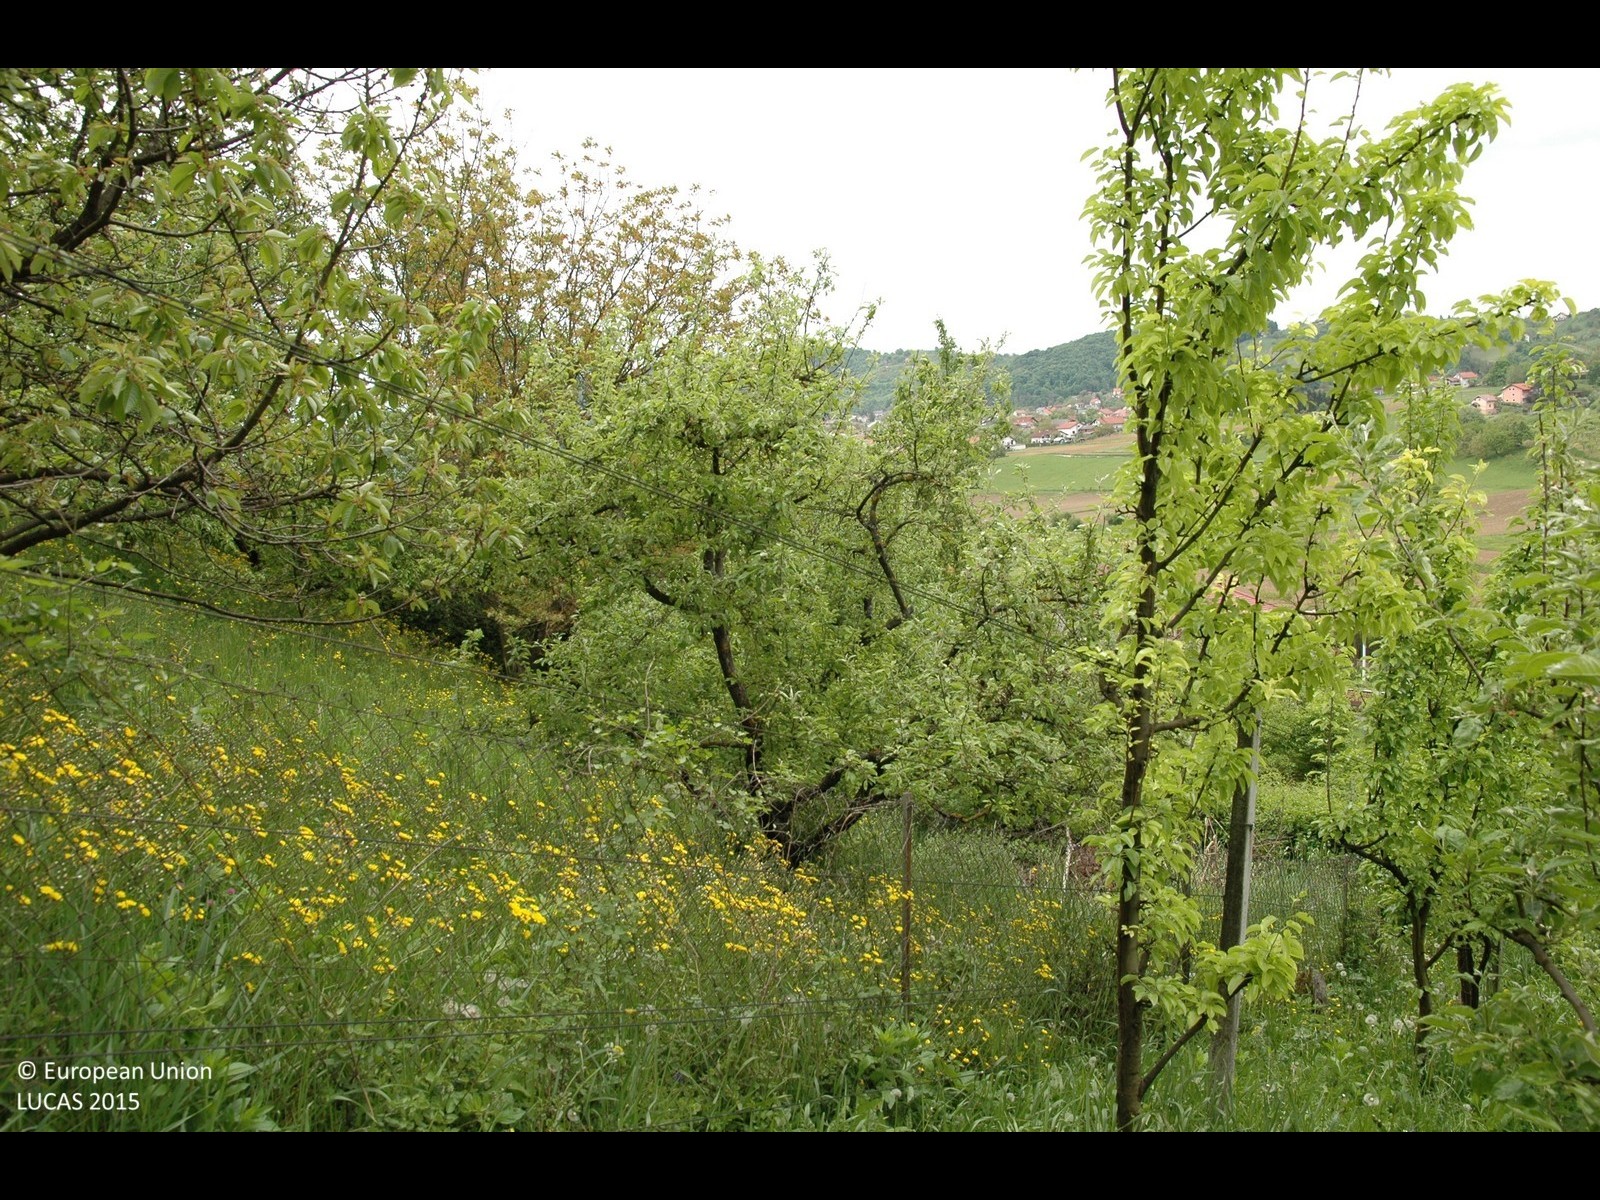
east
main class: Cropland
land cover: Apple fruit
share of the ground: 25 - 50 %
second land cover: Grassland without tree/shrub cover
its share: > 75 %
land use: Agriculture (excluding fallow land and kitchen gardens)
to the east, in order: Apple fruit; Grassland without tree/shrub cover; Fences; Apple fruit; Fences; Spontaneously vegetated surfaces; Grassland without tree/shrub cover; Tracks; Electric lines; Apple fruit; Artificial constructions in urban areas; Rivers and streams; Artificial constructions in urban areas
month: May
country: HR
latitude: 45.7828
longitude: 15.7210
